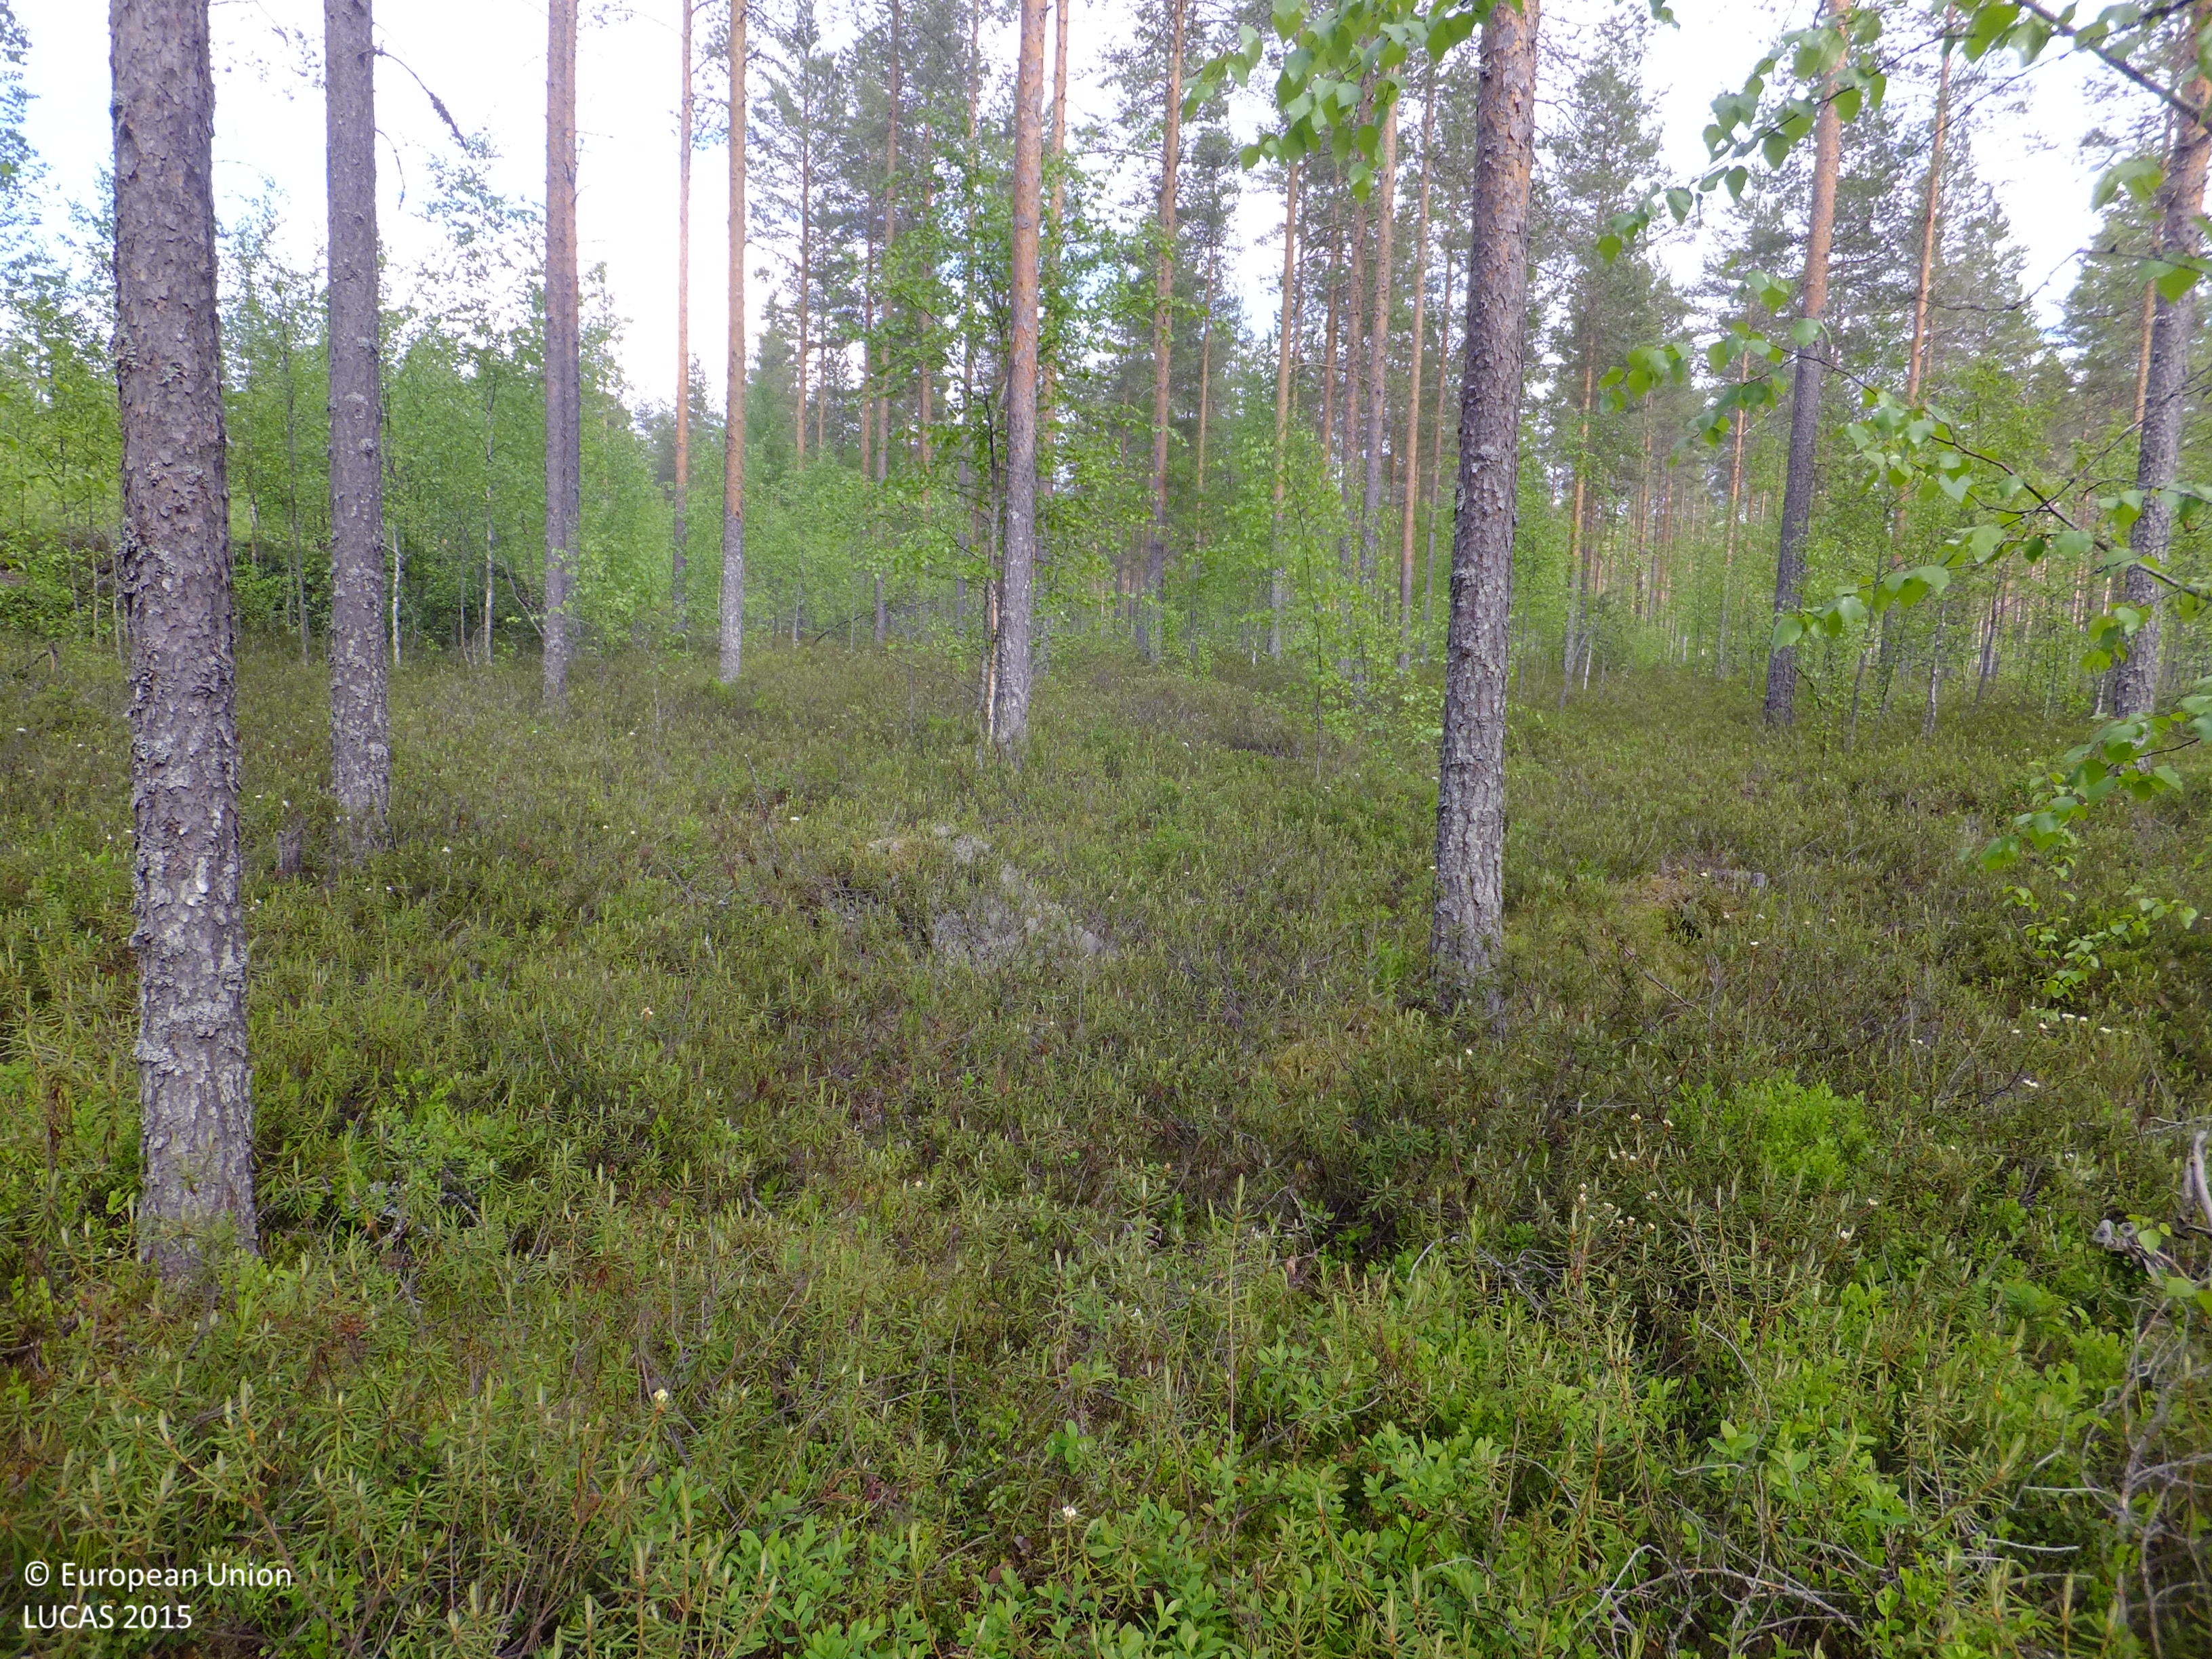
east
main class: Woodland
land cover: Pine dominated coniferous woodland
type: boreal forest
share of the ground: > 75 %
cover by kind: coniferous forest trees 70 %, herbaceous plants 15 %, shrubs 10 %, broadleaved forest trees 5 %
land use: Forestry
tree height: > 5 m
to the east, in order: Pine dominated coniferous woodland; Tracks; Pine dominated coniferous woodland; Shrubland with sparse tree cover; Pine dominated coniferous woodland; Tracks; Pine dominated coniferous woodland; Tracks; Pine dominated coniferous woodland
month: June
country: FI
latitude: 63.4852
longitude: 24.7210
